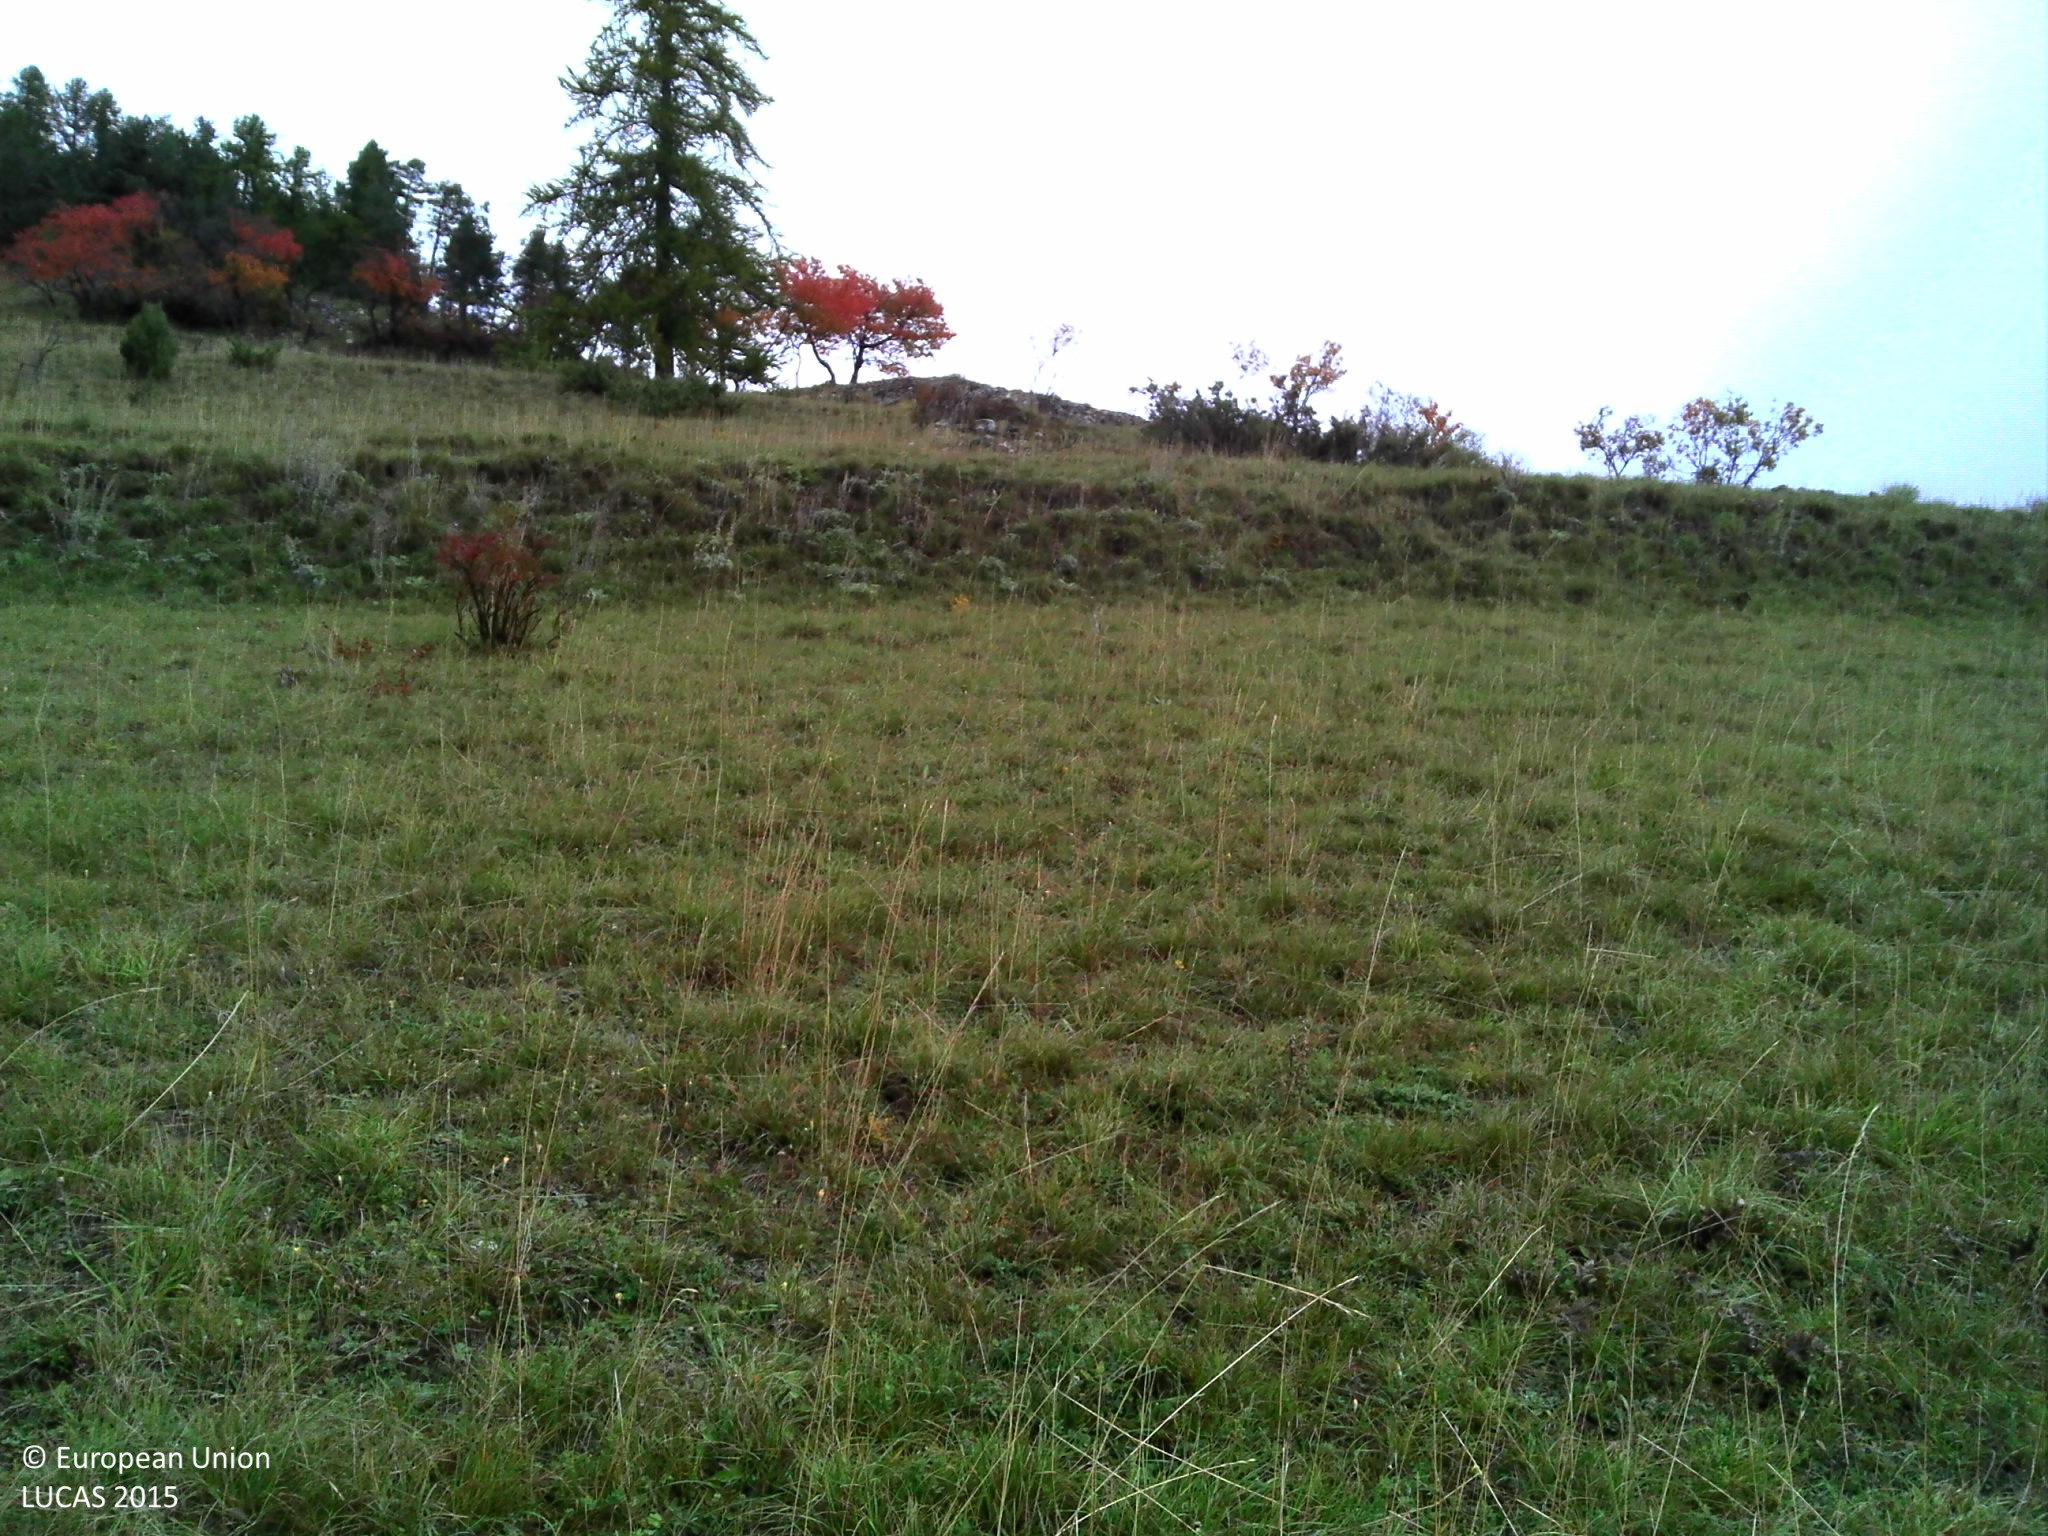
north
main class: Grassland
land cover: Grassland without tree/shrub cover
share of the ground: > 75 %
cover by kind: herbaceous plants 90 %, shrubs 5 %, consolidated bare surface 5 %
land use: Agriculture (excluding fallow land and kitchen gardens)
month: October
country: FR
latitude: 44.7684
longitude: 6.7332
